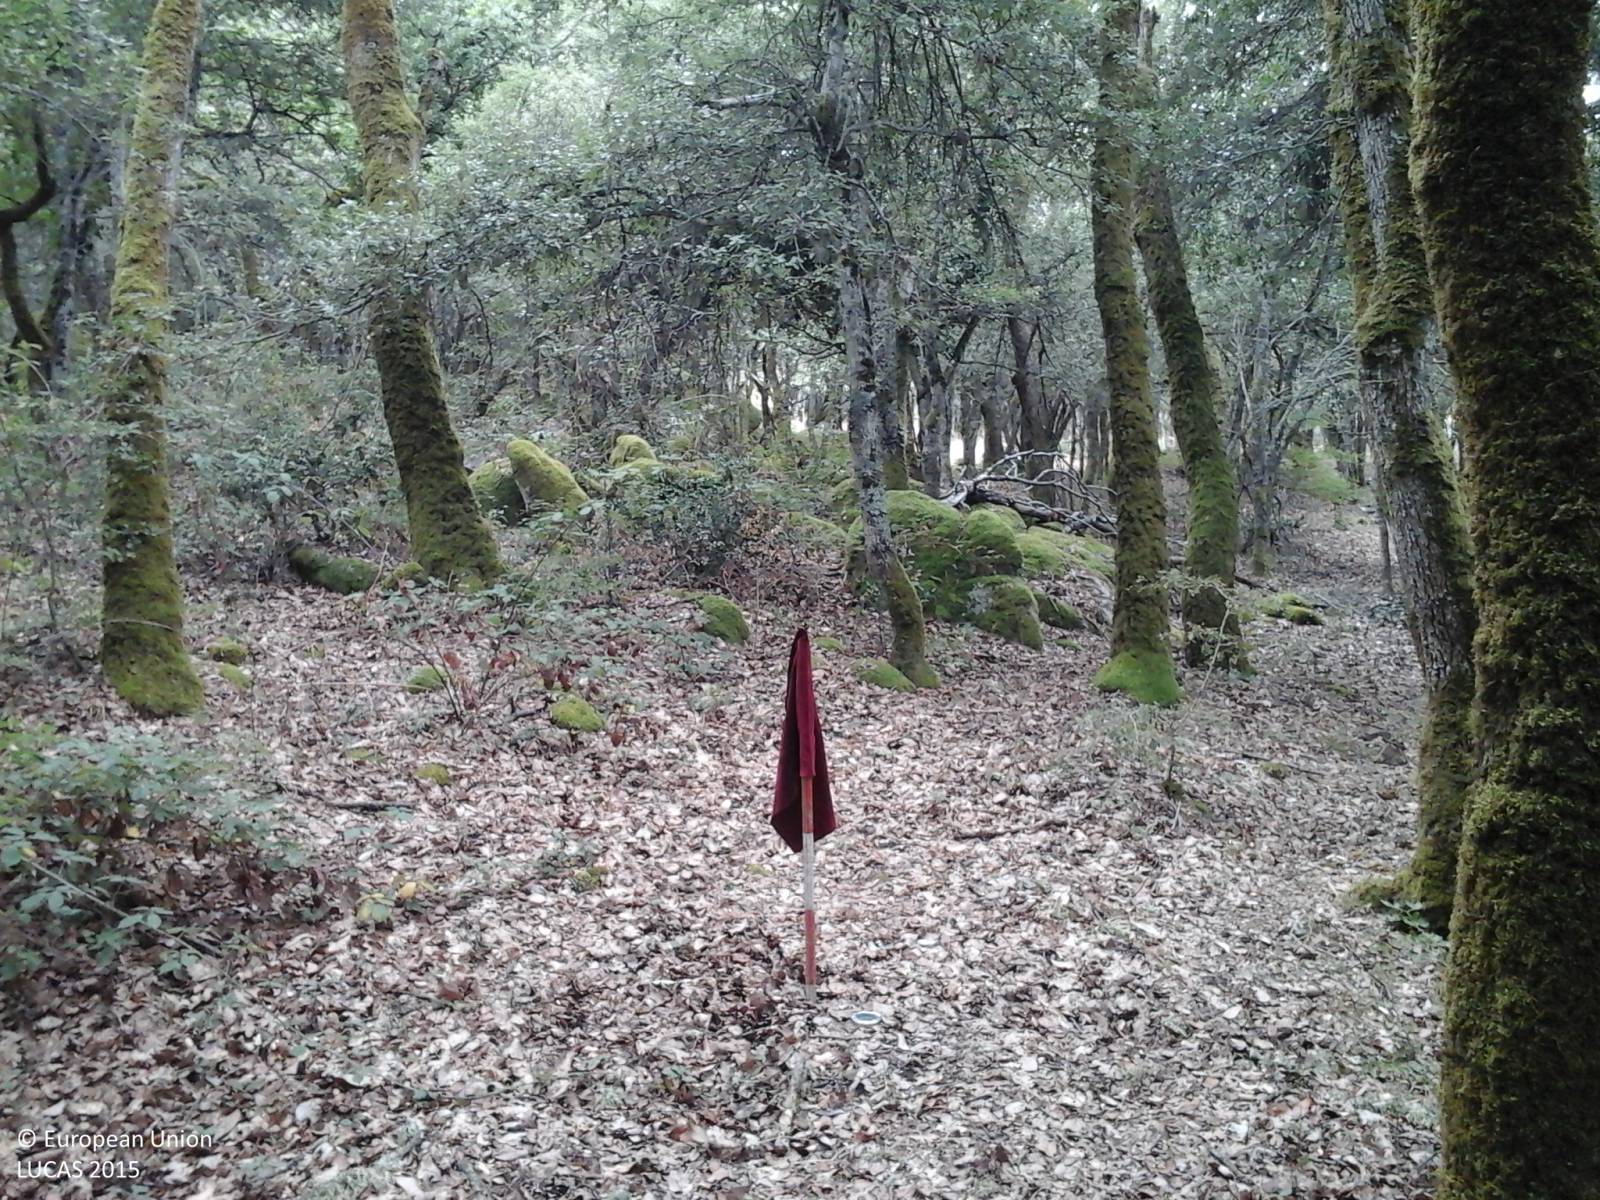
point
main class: Woodland
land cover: Broadleaved woodland
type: coniferous forest of the mediterranean region
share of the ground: > 75 %
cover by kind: herbaceous plants 80 %, broadleaved forest trees 10 %, shrubs 10 %
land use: Forestry
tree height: > 5 m
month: August
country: IT
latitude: 40.5164
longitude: 9.0723
